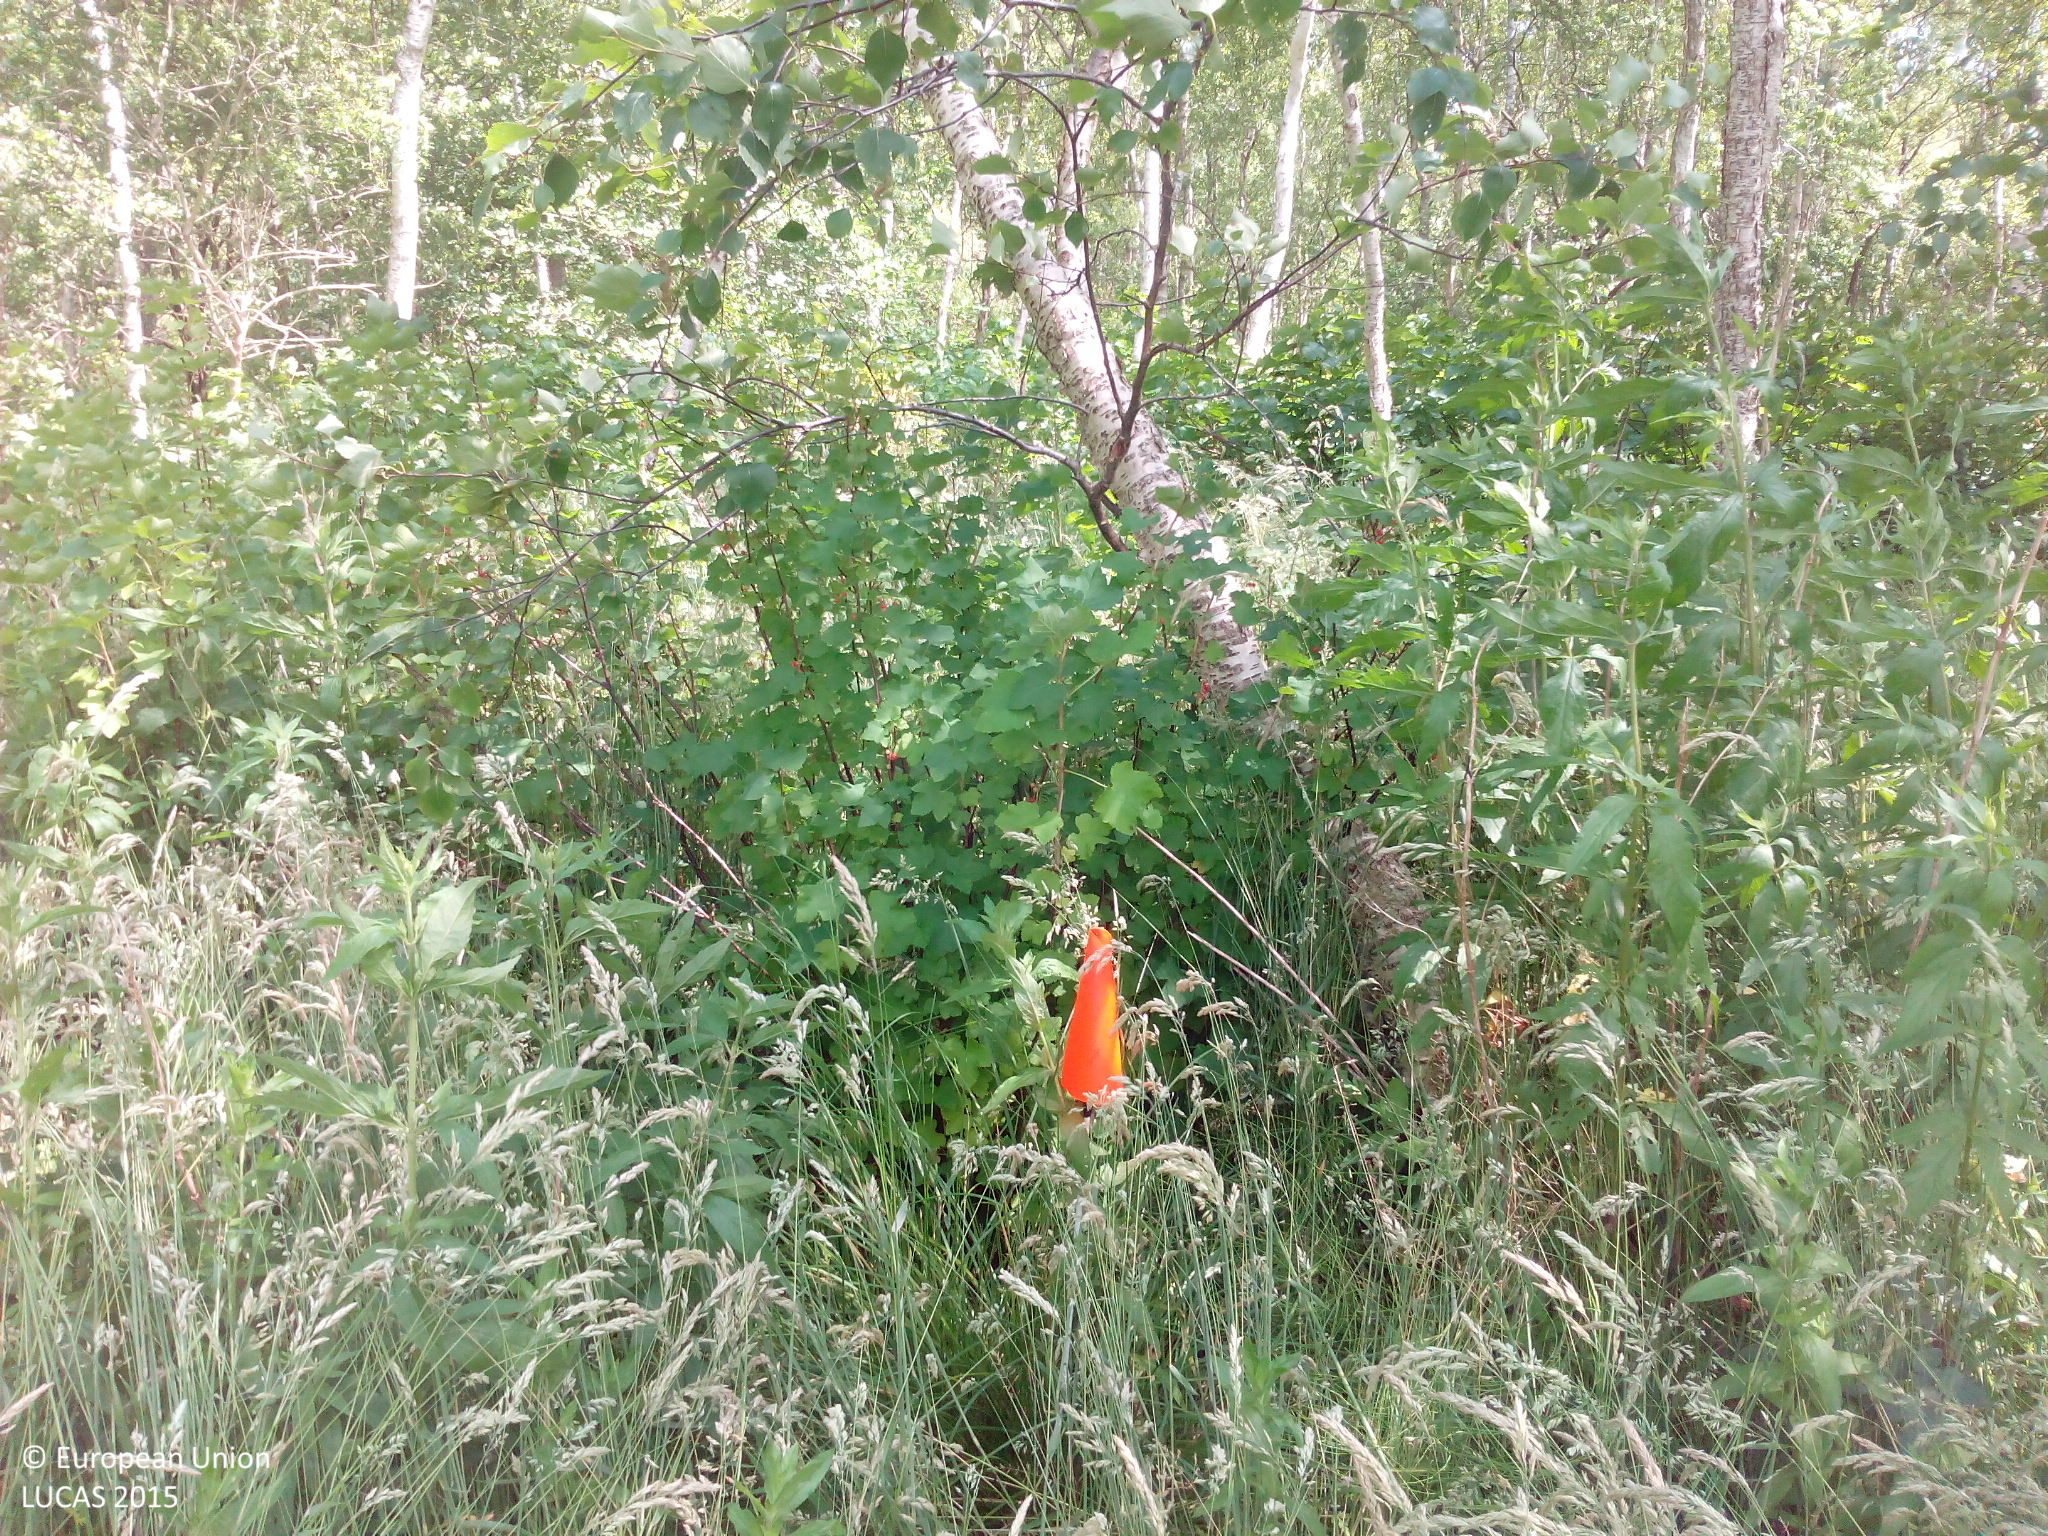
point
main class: Woodland
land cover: Broadleaved woodland
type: mesophytic deciduous forest
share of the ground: > 75 %
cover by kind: broadleaved forest trees 80 %, herbaceous plants 15 %, shrubs 5 %
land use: Semi-natural and natural areas not in use
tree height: > 5 m
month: July
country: DE
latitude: 53.9692
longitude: 13.2769
